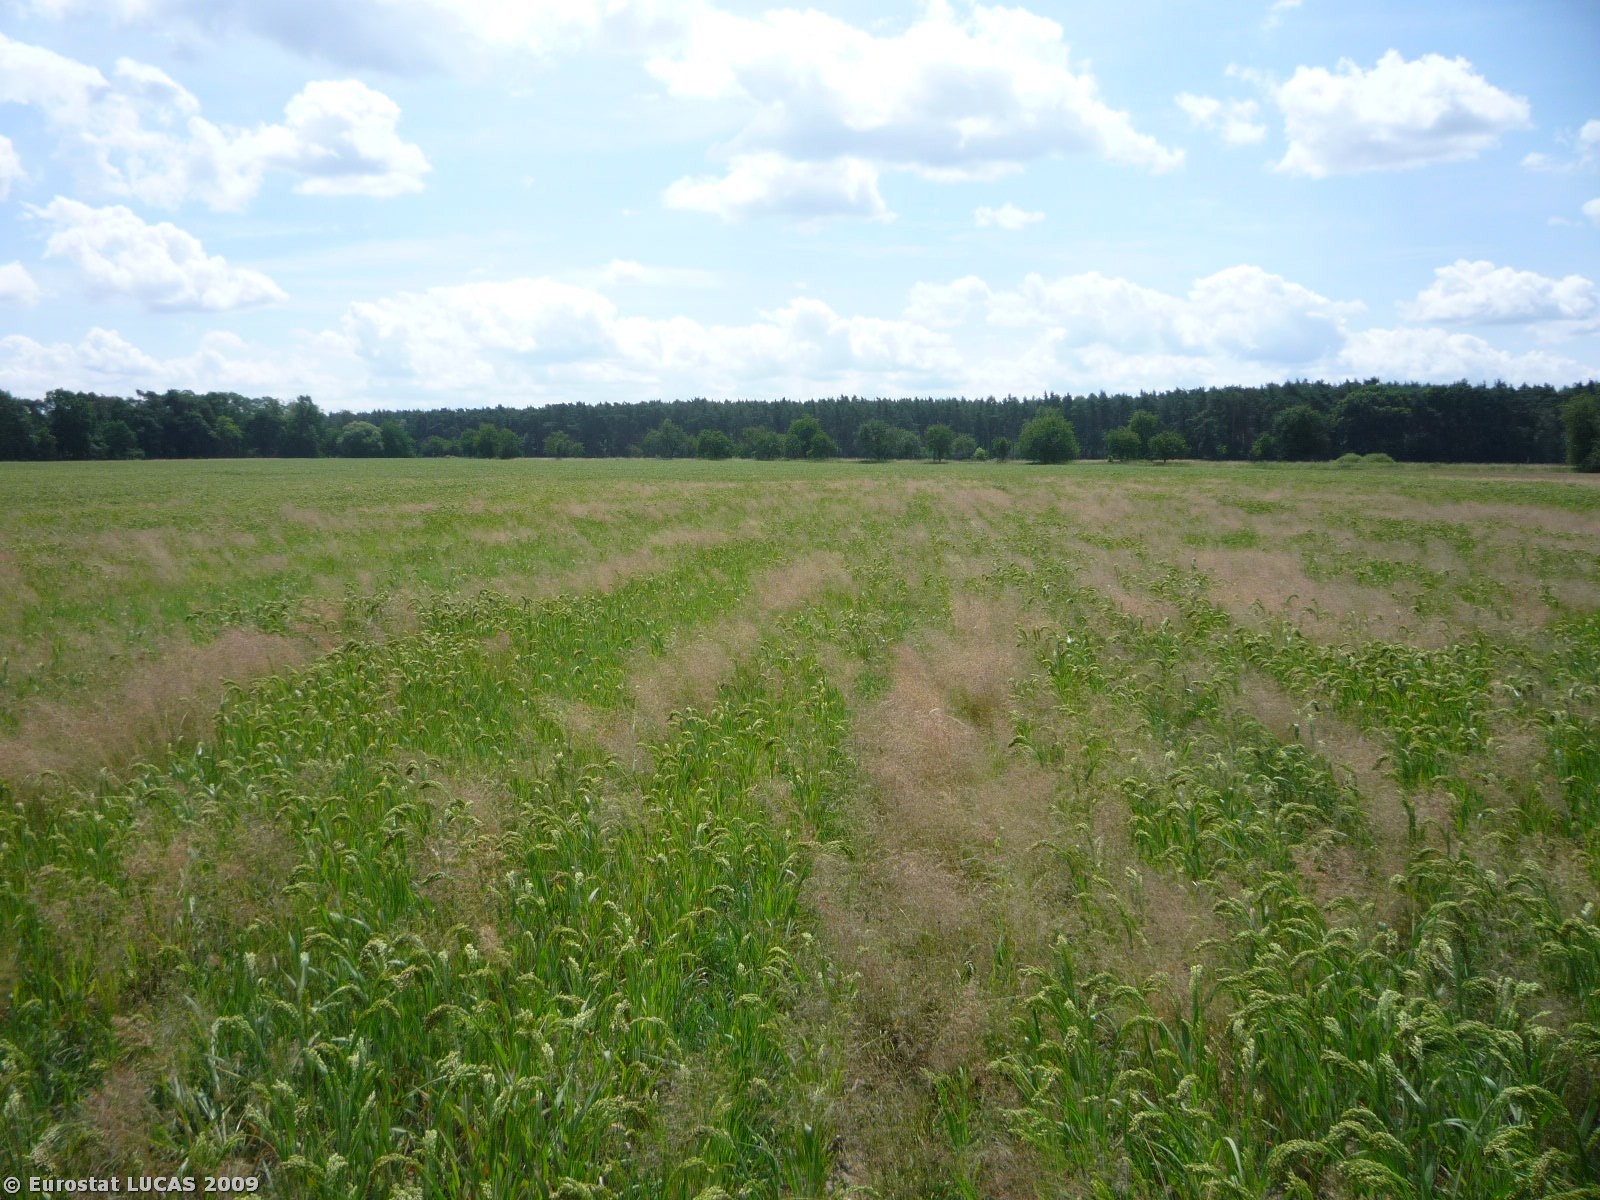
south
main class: Cropland
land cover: Other cereals
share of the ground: > 75 %
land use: Agriculture (excluding fallow land and kitchen gardens)
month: July
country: CZ
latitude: 50.1455
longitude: 15.0265
